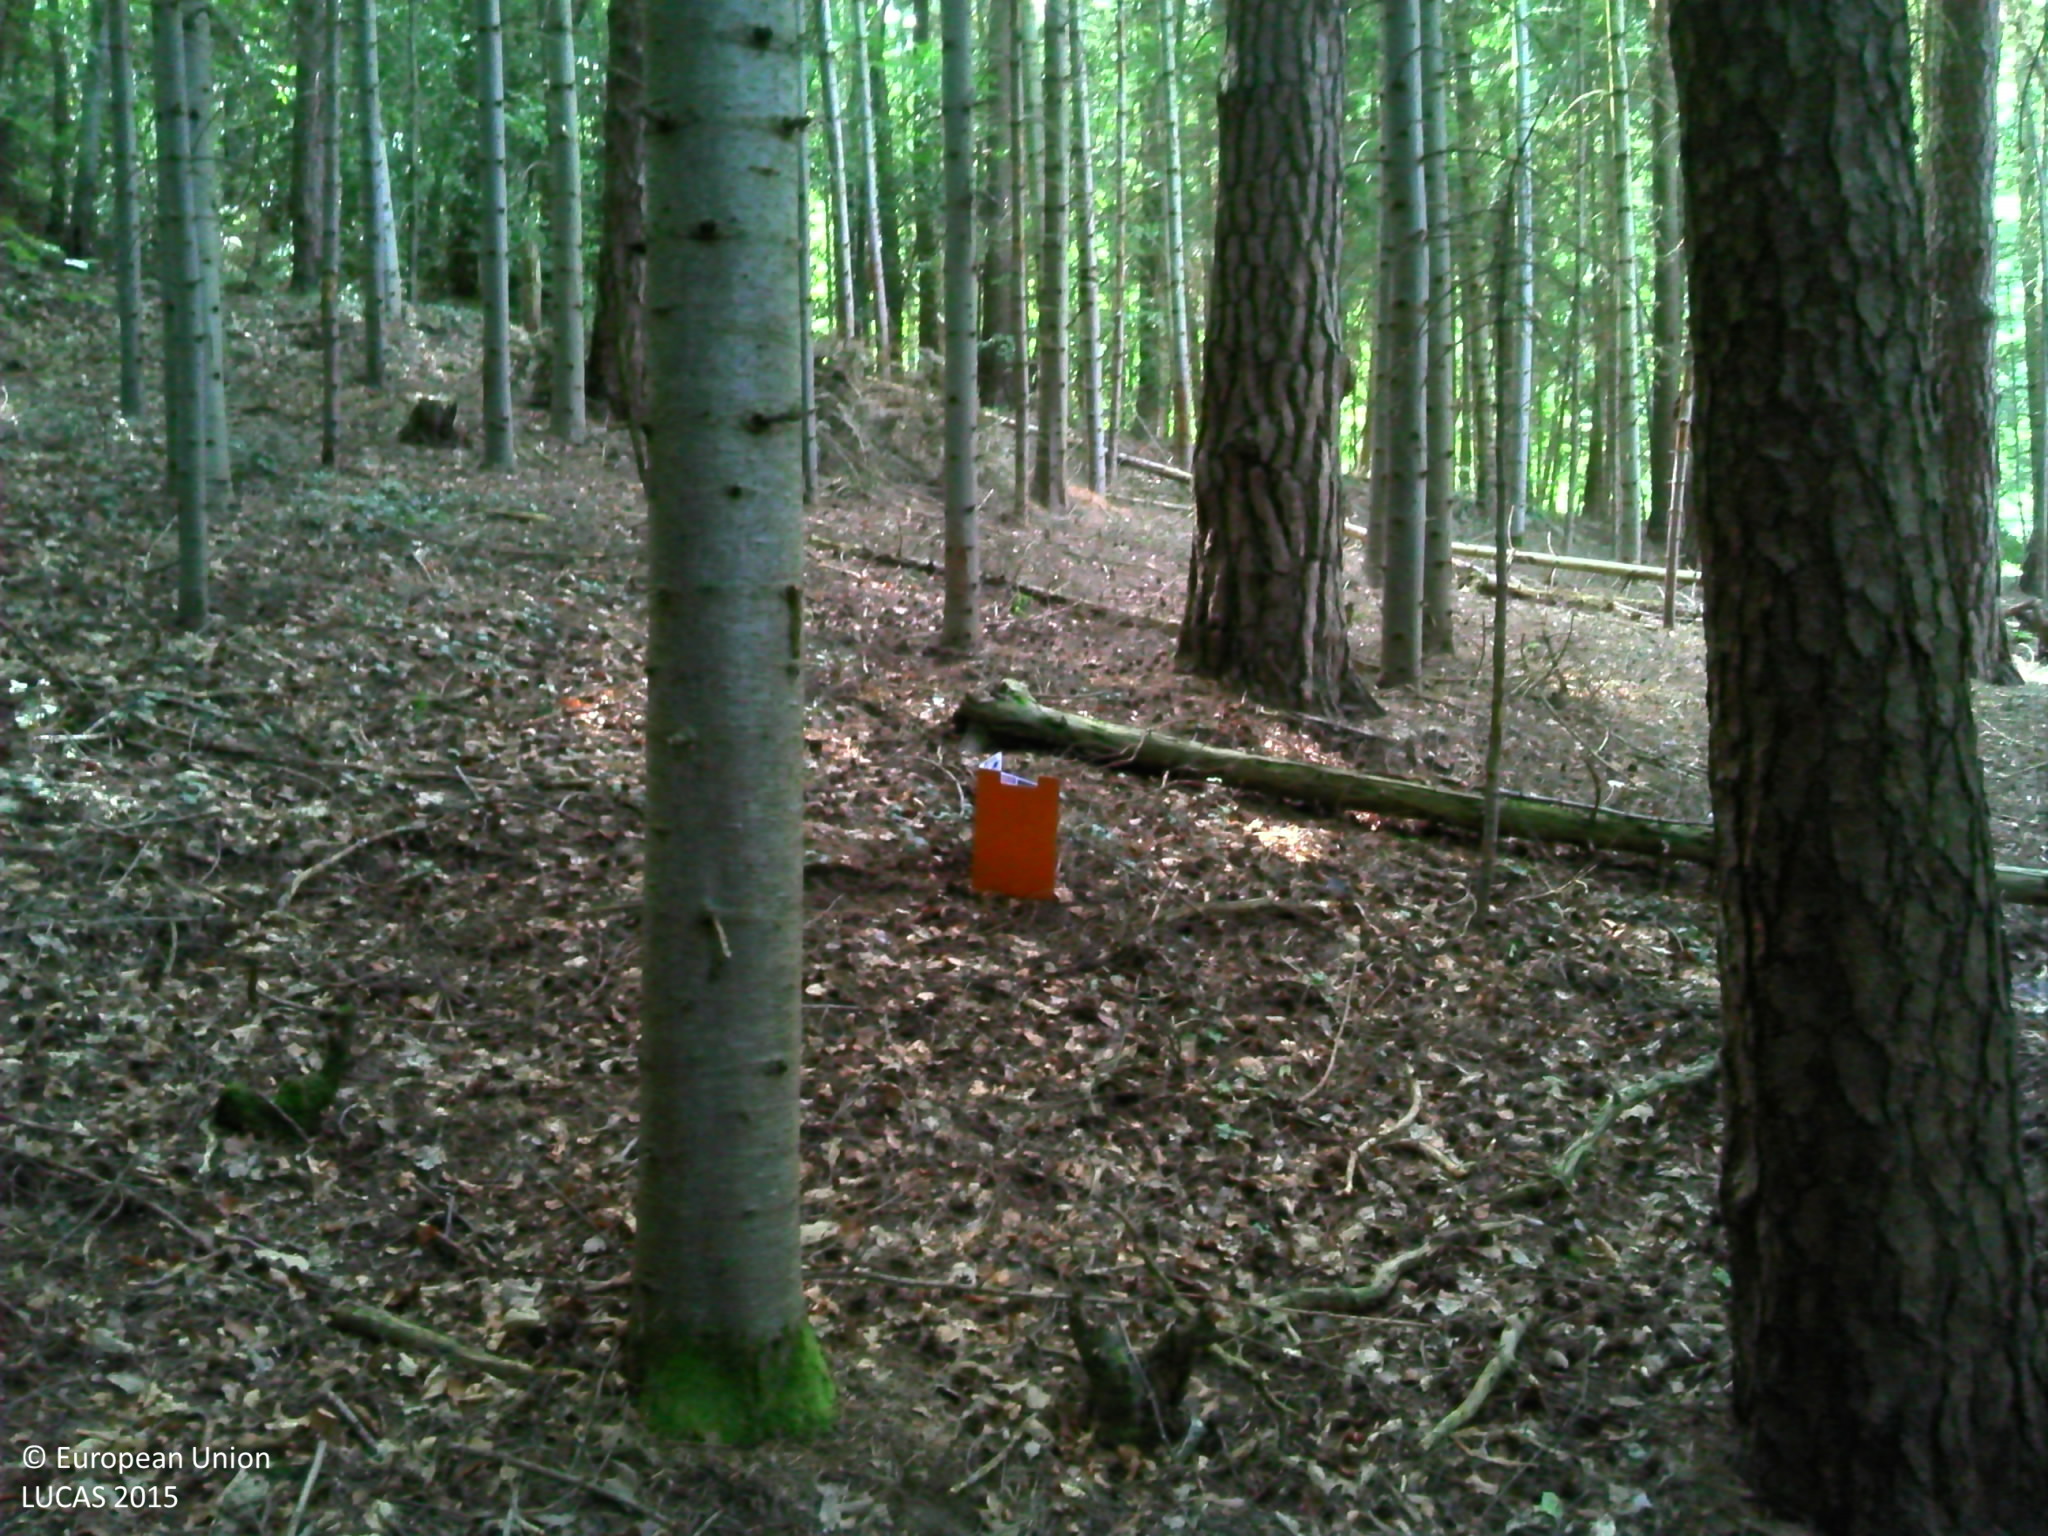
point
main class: Woodland
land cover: Spruce dominated coniferous woodland
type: hemiboreal forest and nemoral coniferous forest and mixed broadleaved-coniferous forest
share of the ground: > 75 %
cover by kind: coniferous forest trees 95 %, unconsolidated bare surface 5 %
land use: Forestry
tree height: > 5 m
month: July
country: FR
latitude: 45.1712
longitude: 3.1183
